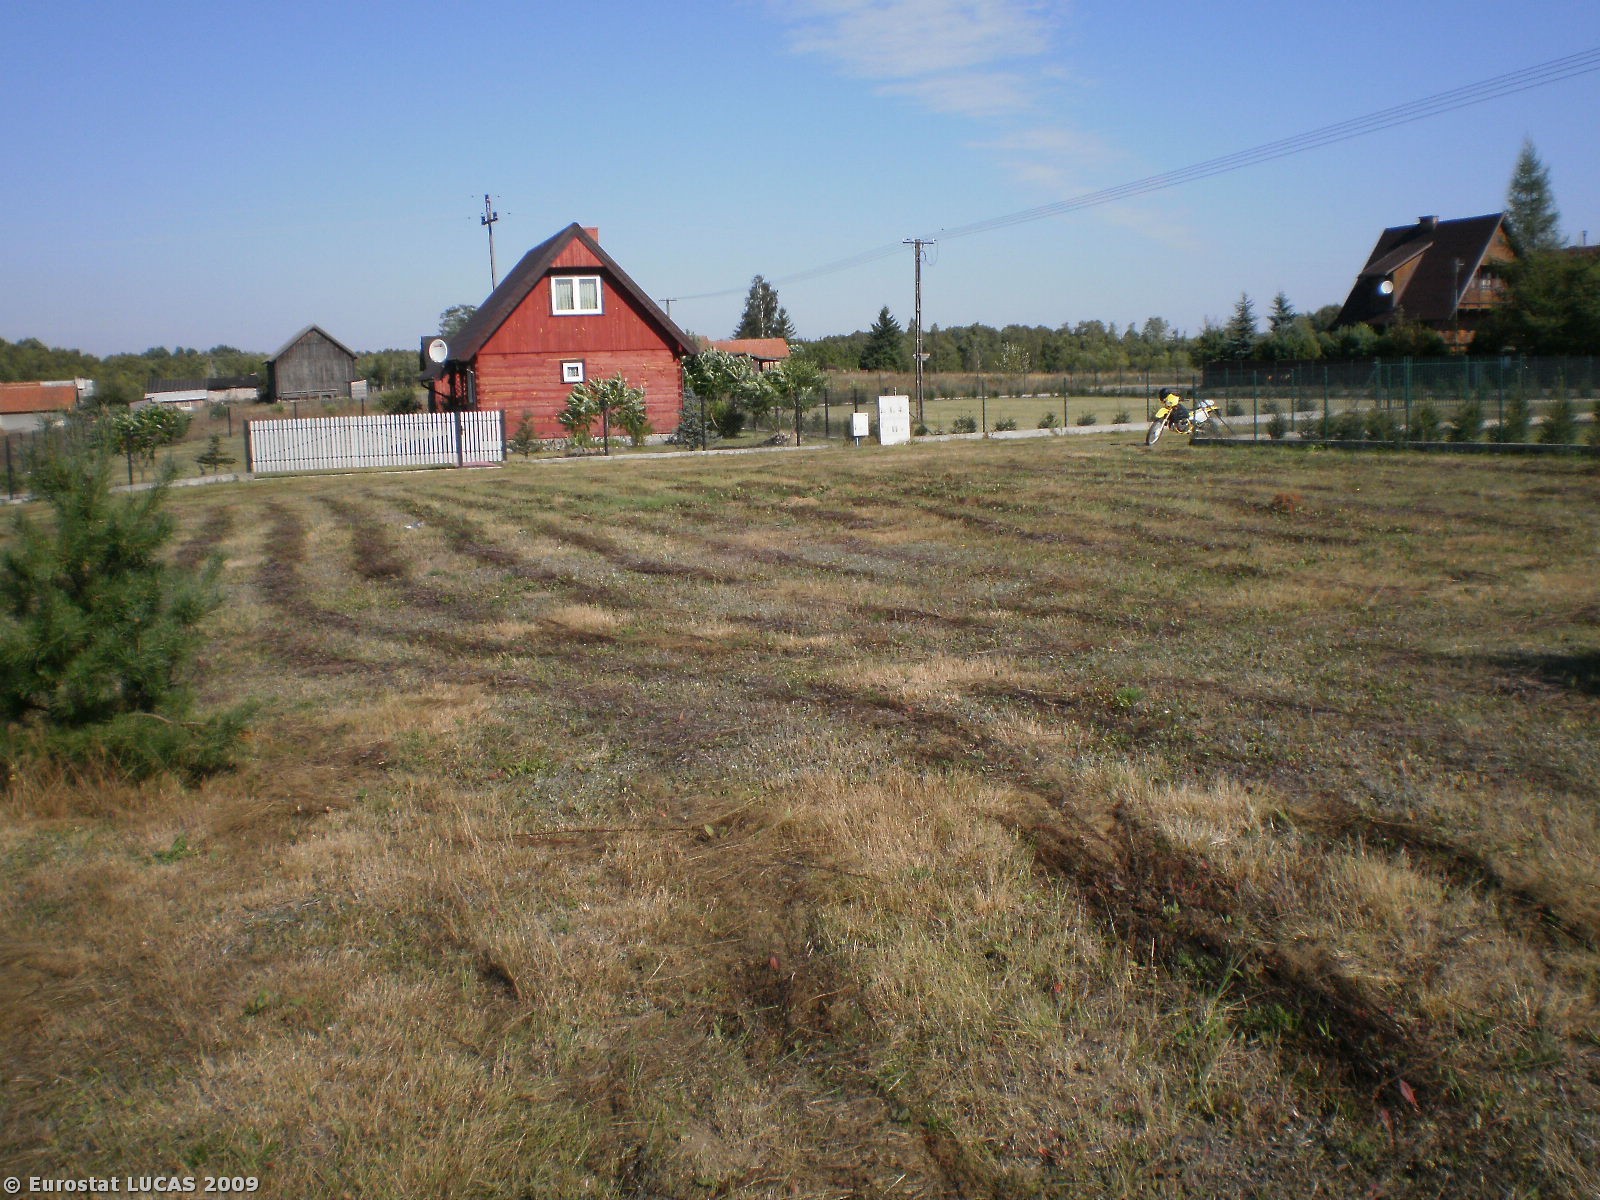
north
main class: Grassland
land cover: Grassland with sparse tree/shrub cover
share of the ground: > 75 %
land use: Agriculture (excluding fallow land and kitchen gardens)
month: September
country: PL
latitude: 53.6093
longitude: 21.3688
